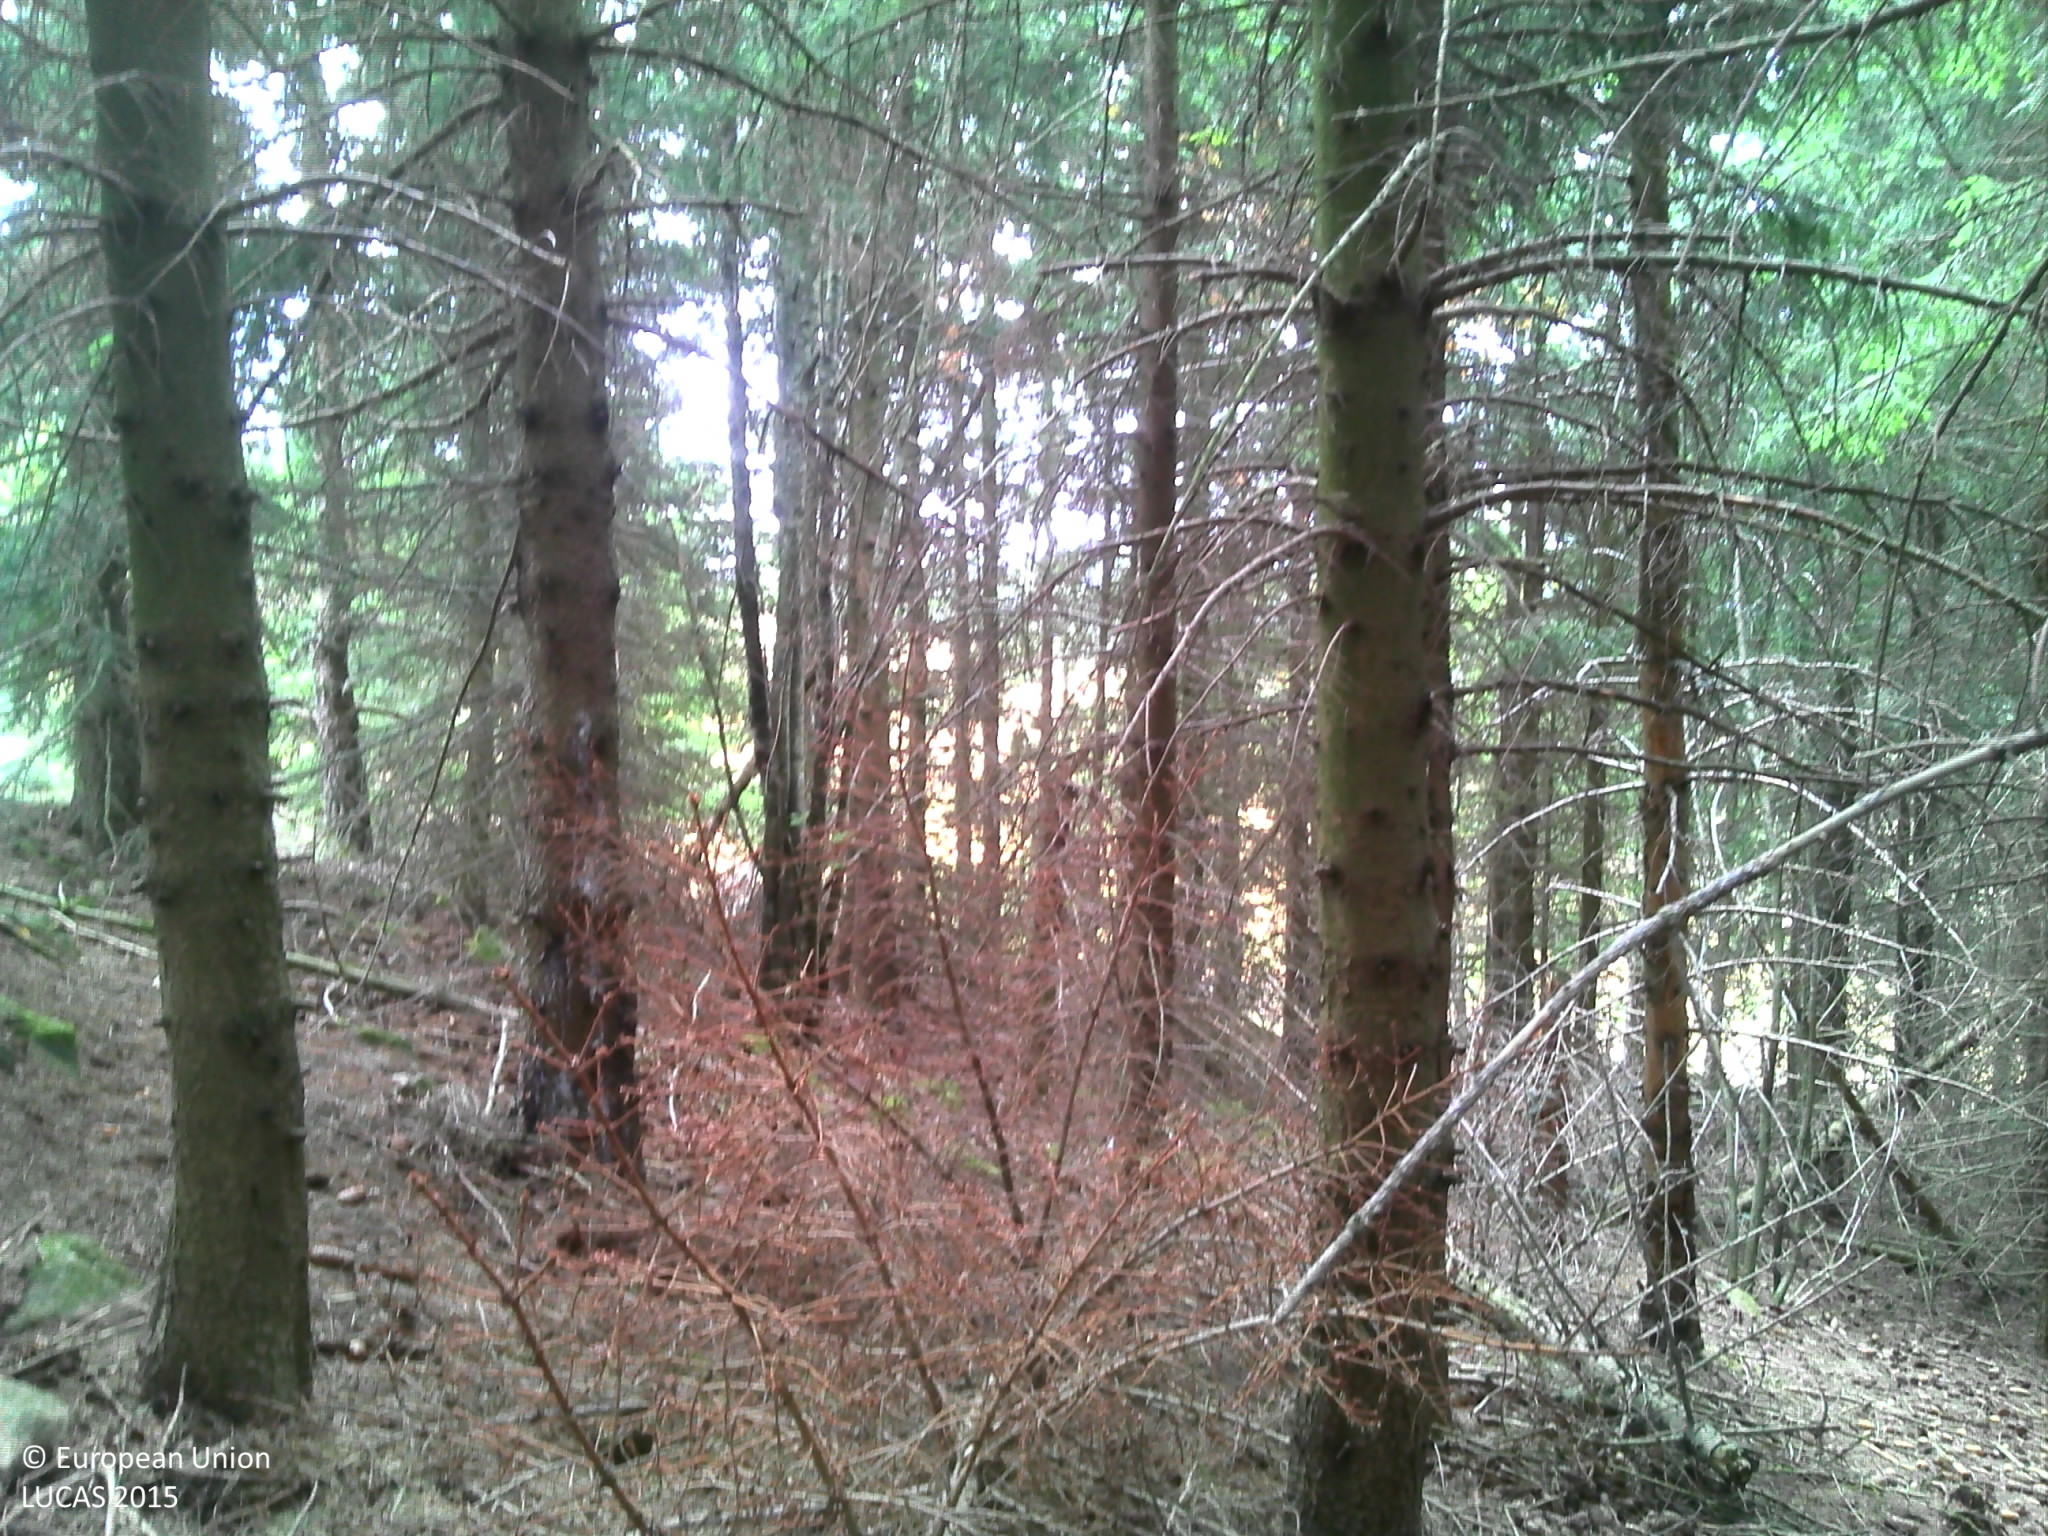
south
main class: Woodland
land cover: Spruce dominated coniferous woodland
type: alpine coniferous forest
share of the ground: > 75 %
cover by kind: coniferous forest trees 90 %, unconsolidated bare surface 10 %
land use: Forestry
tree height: > 5 m
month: September
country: FR
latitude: 44.8970
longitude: 4.2688
